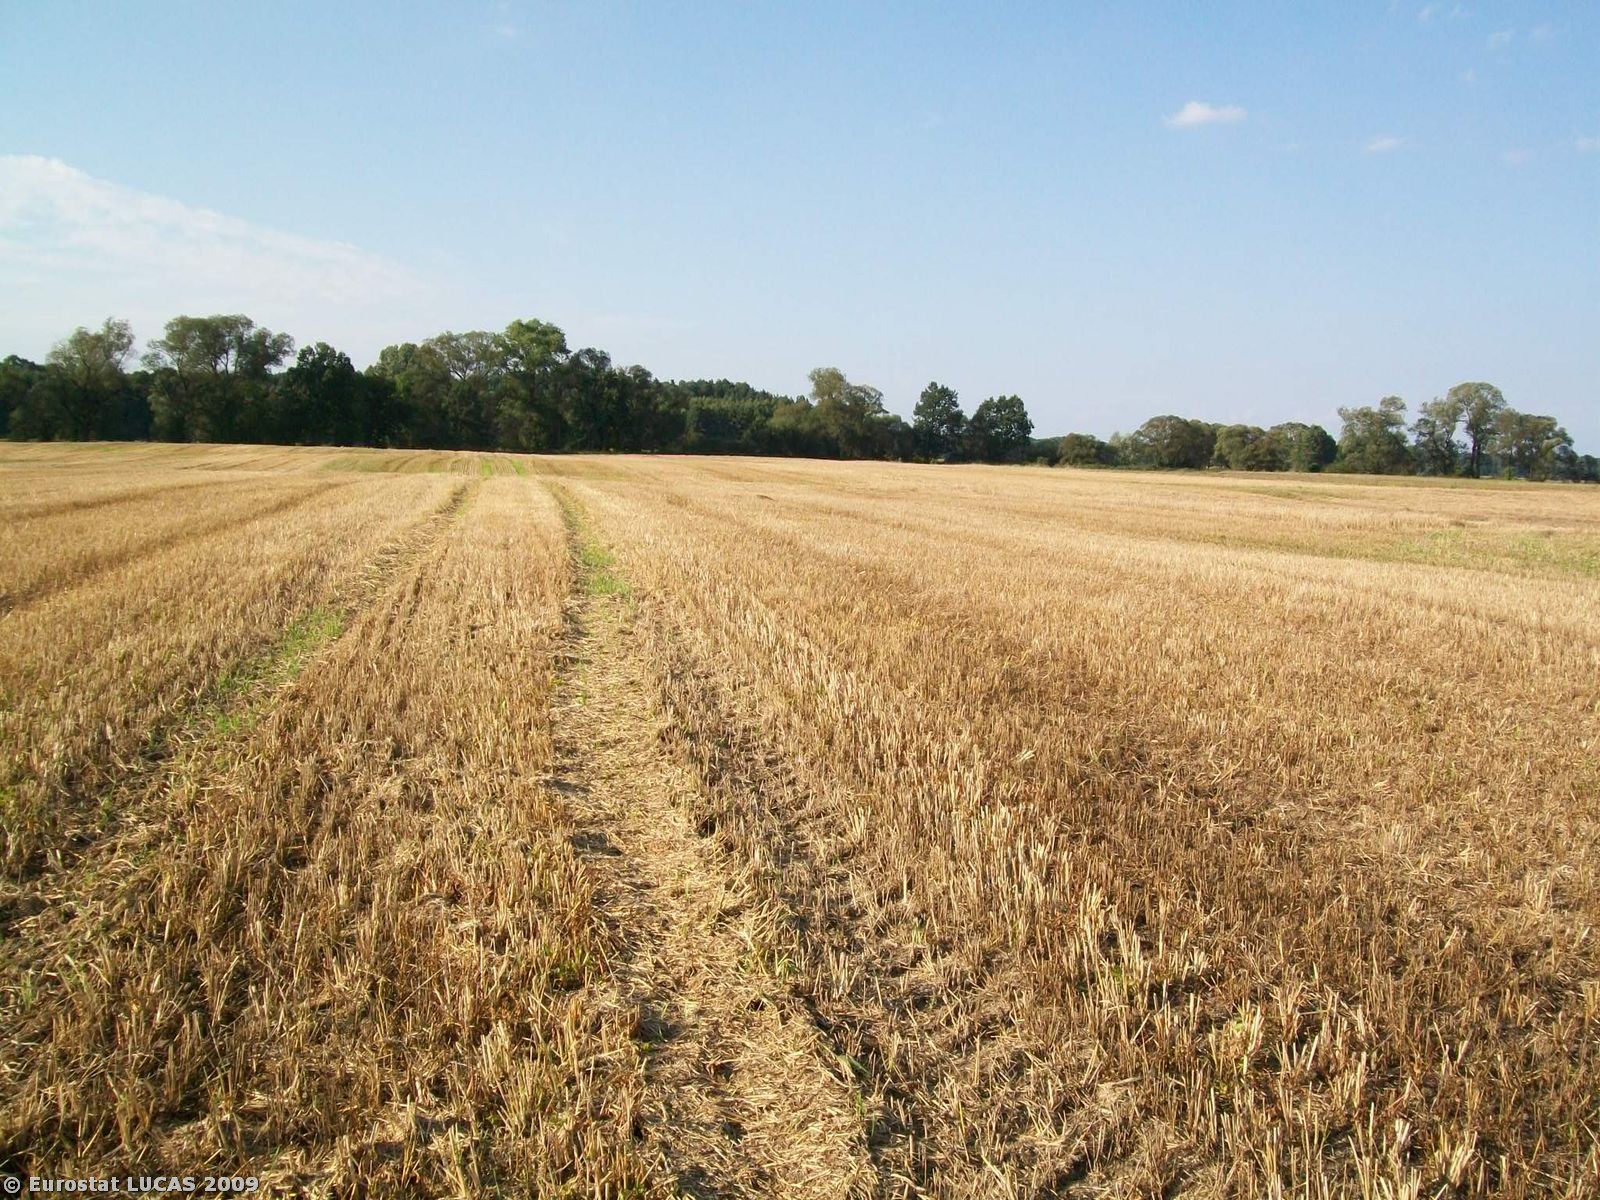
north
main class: Cropland
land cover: Barley
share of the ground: < 10 %
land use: Agriculture (excluding fallow land and kitchen gardens)
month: August
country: PL
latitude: 50.9745
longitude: 17.9196
